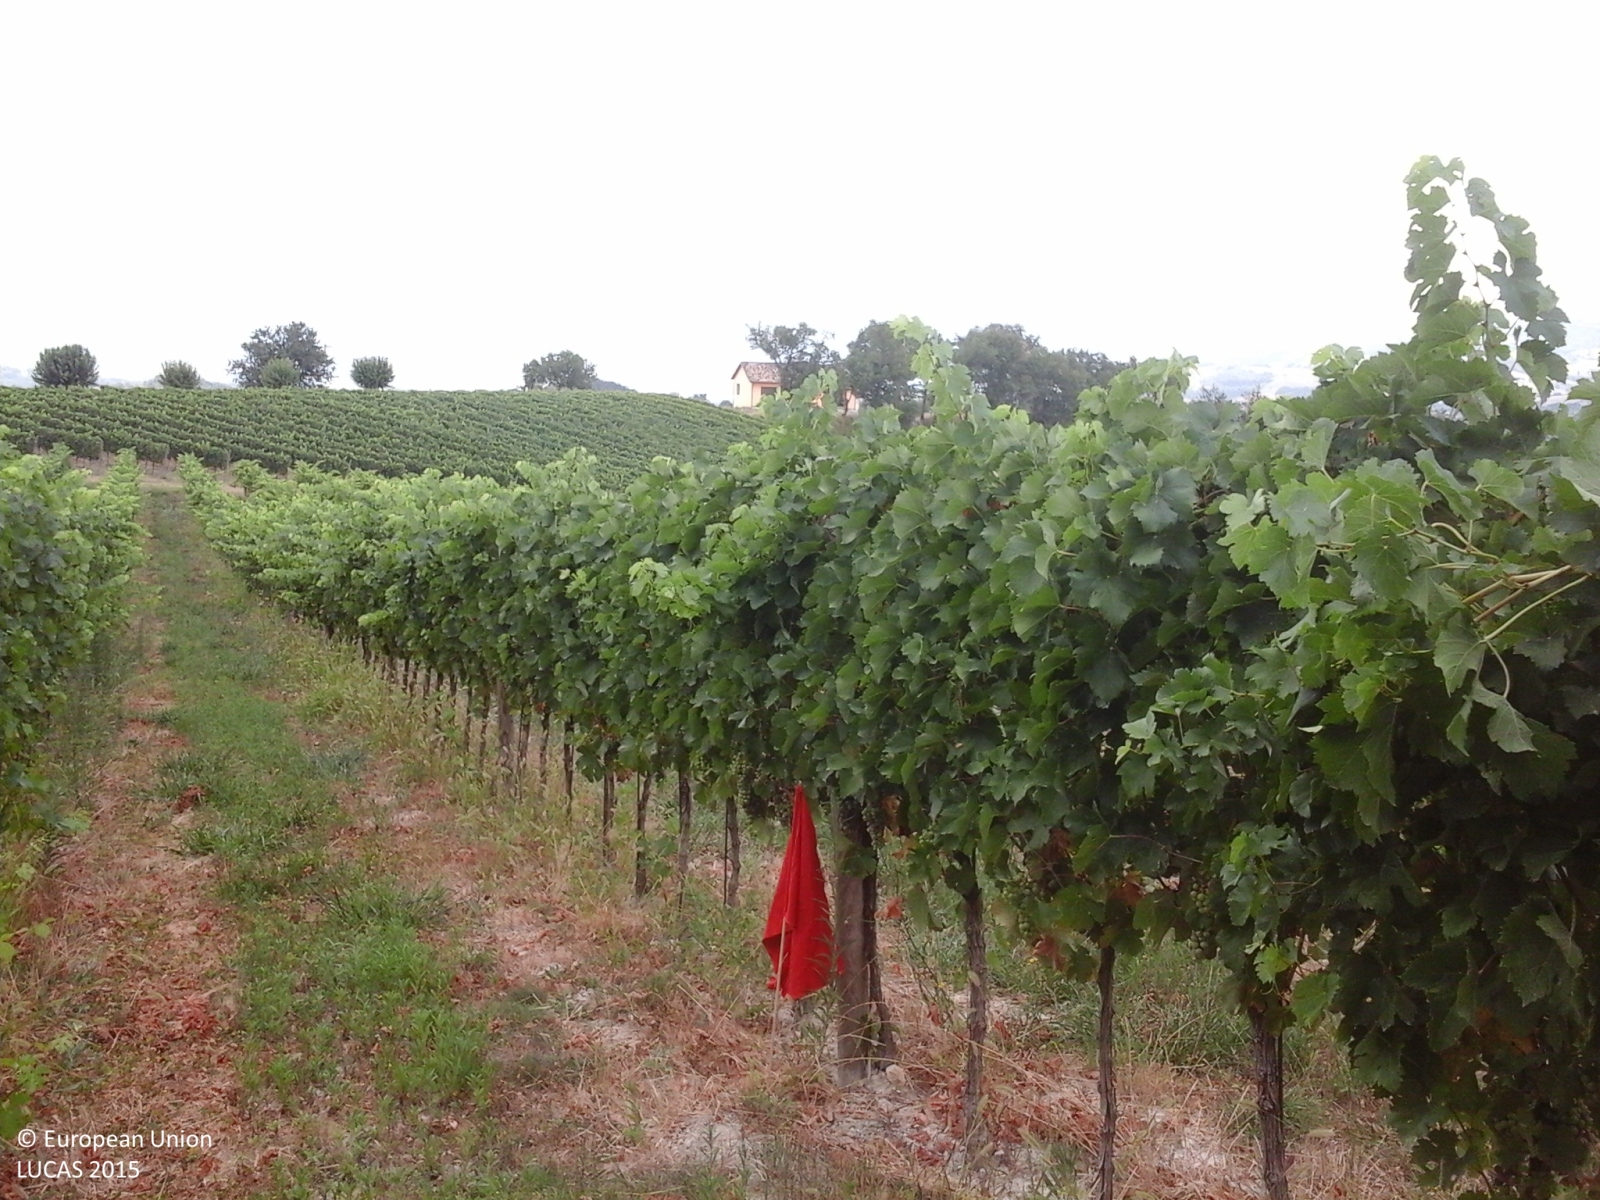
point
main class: Cropland
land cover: Vineyards
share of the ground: 50 - 75 %
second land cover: Spontaneously vegetated surfaces
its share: 50 - 75 %
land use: Agriculture (excluding fallow land and kitchen gardens)
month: July
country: IT
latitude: 43.2718
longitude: 13.2074
